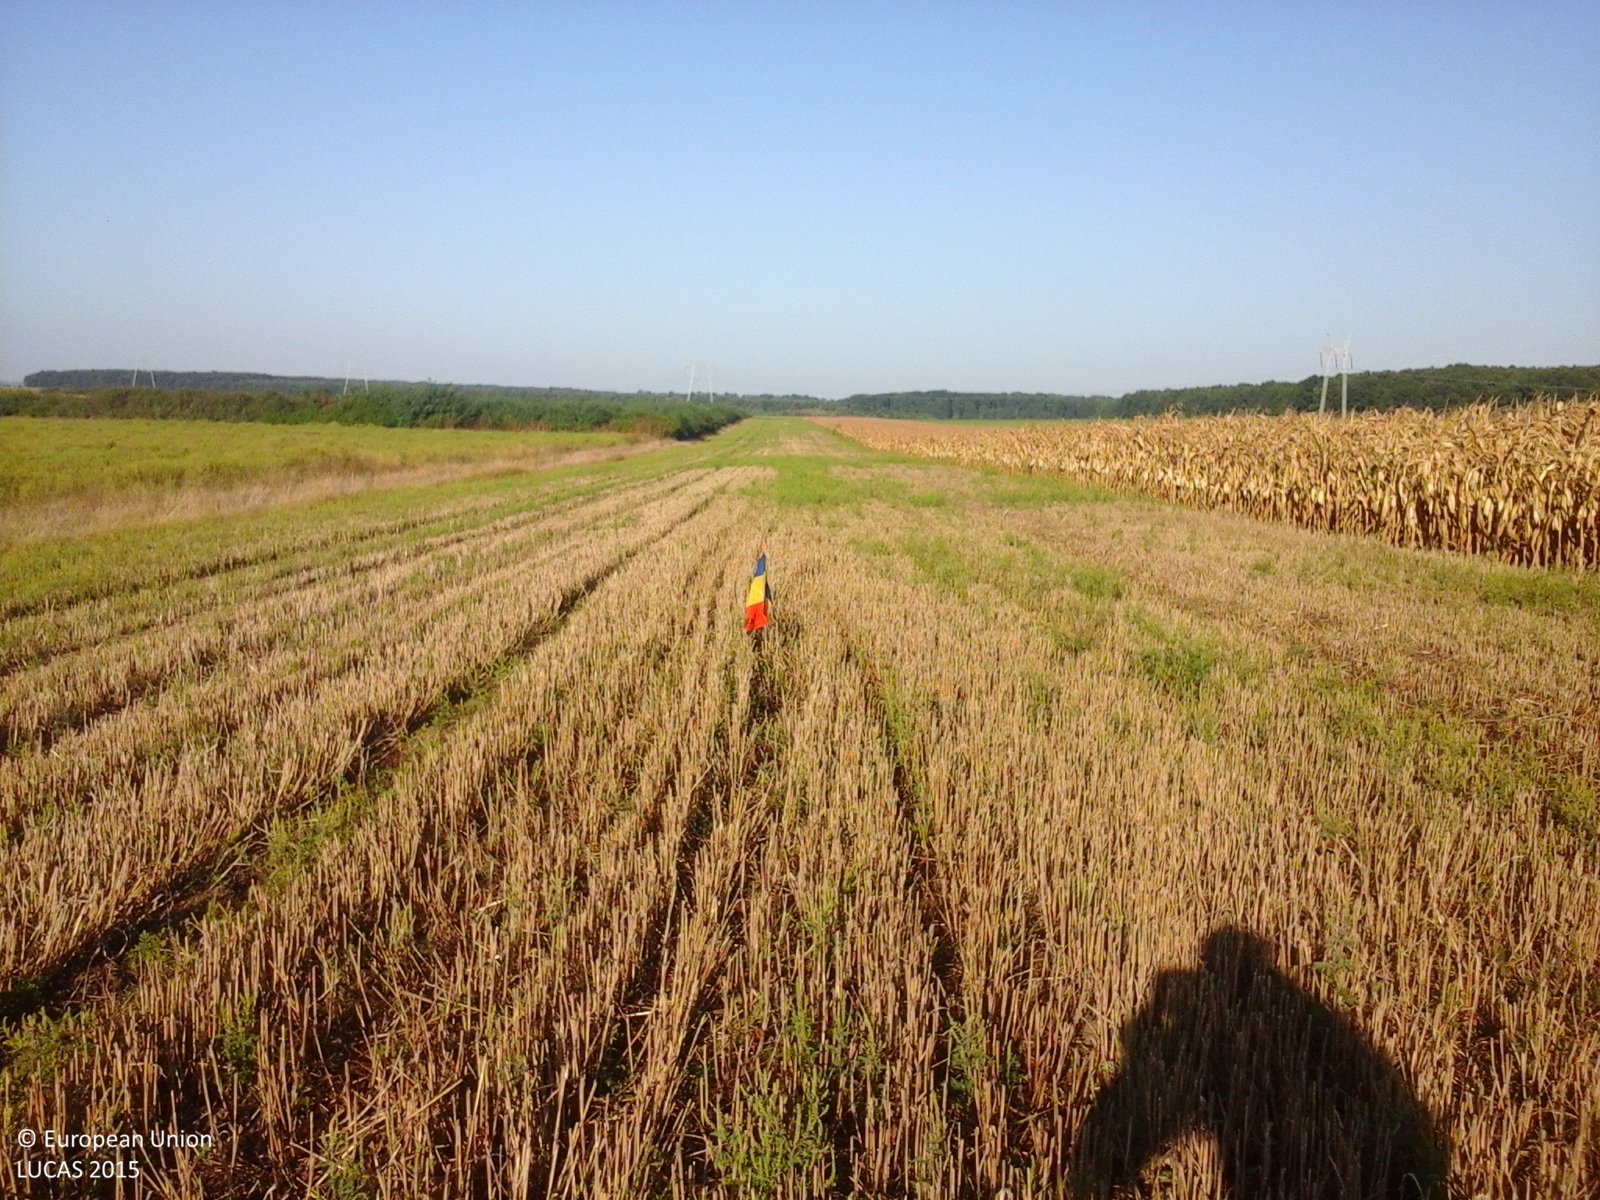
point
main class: Cropland
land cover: Common wheat
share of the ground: > 75 %
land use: Agriculture (excluding fallow land and kitchen gardens)
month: September
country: RO
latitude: 47.5929
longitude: 22.8700
